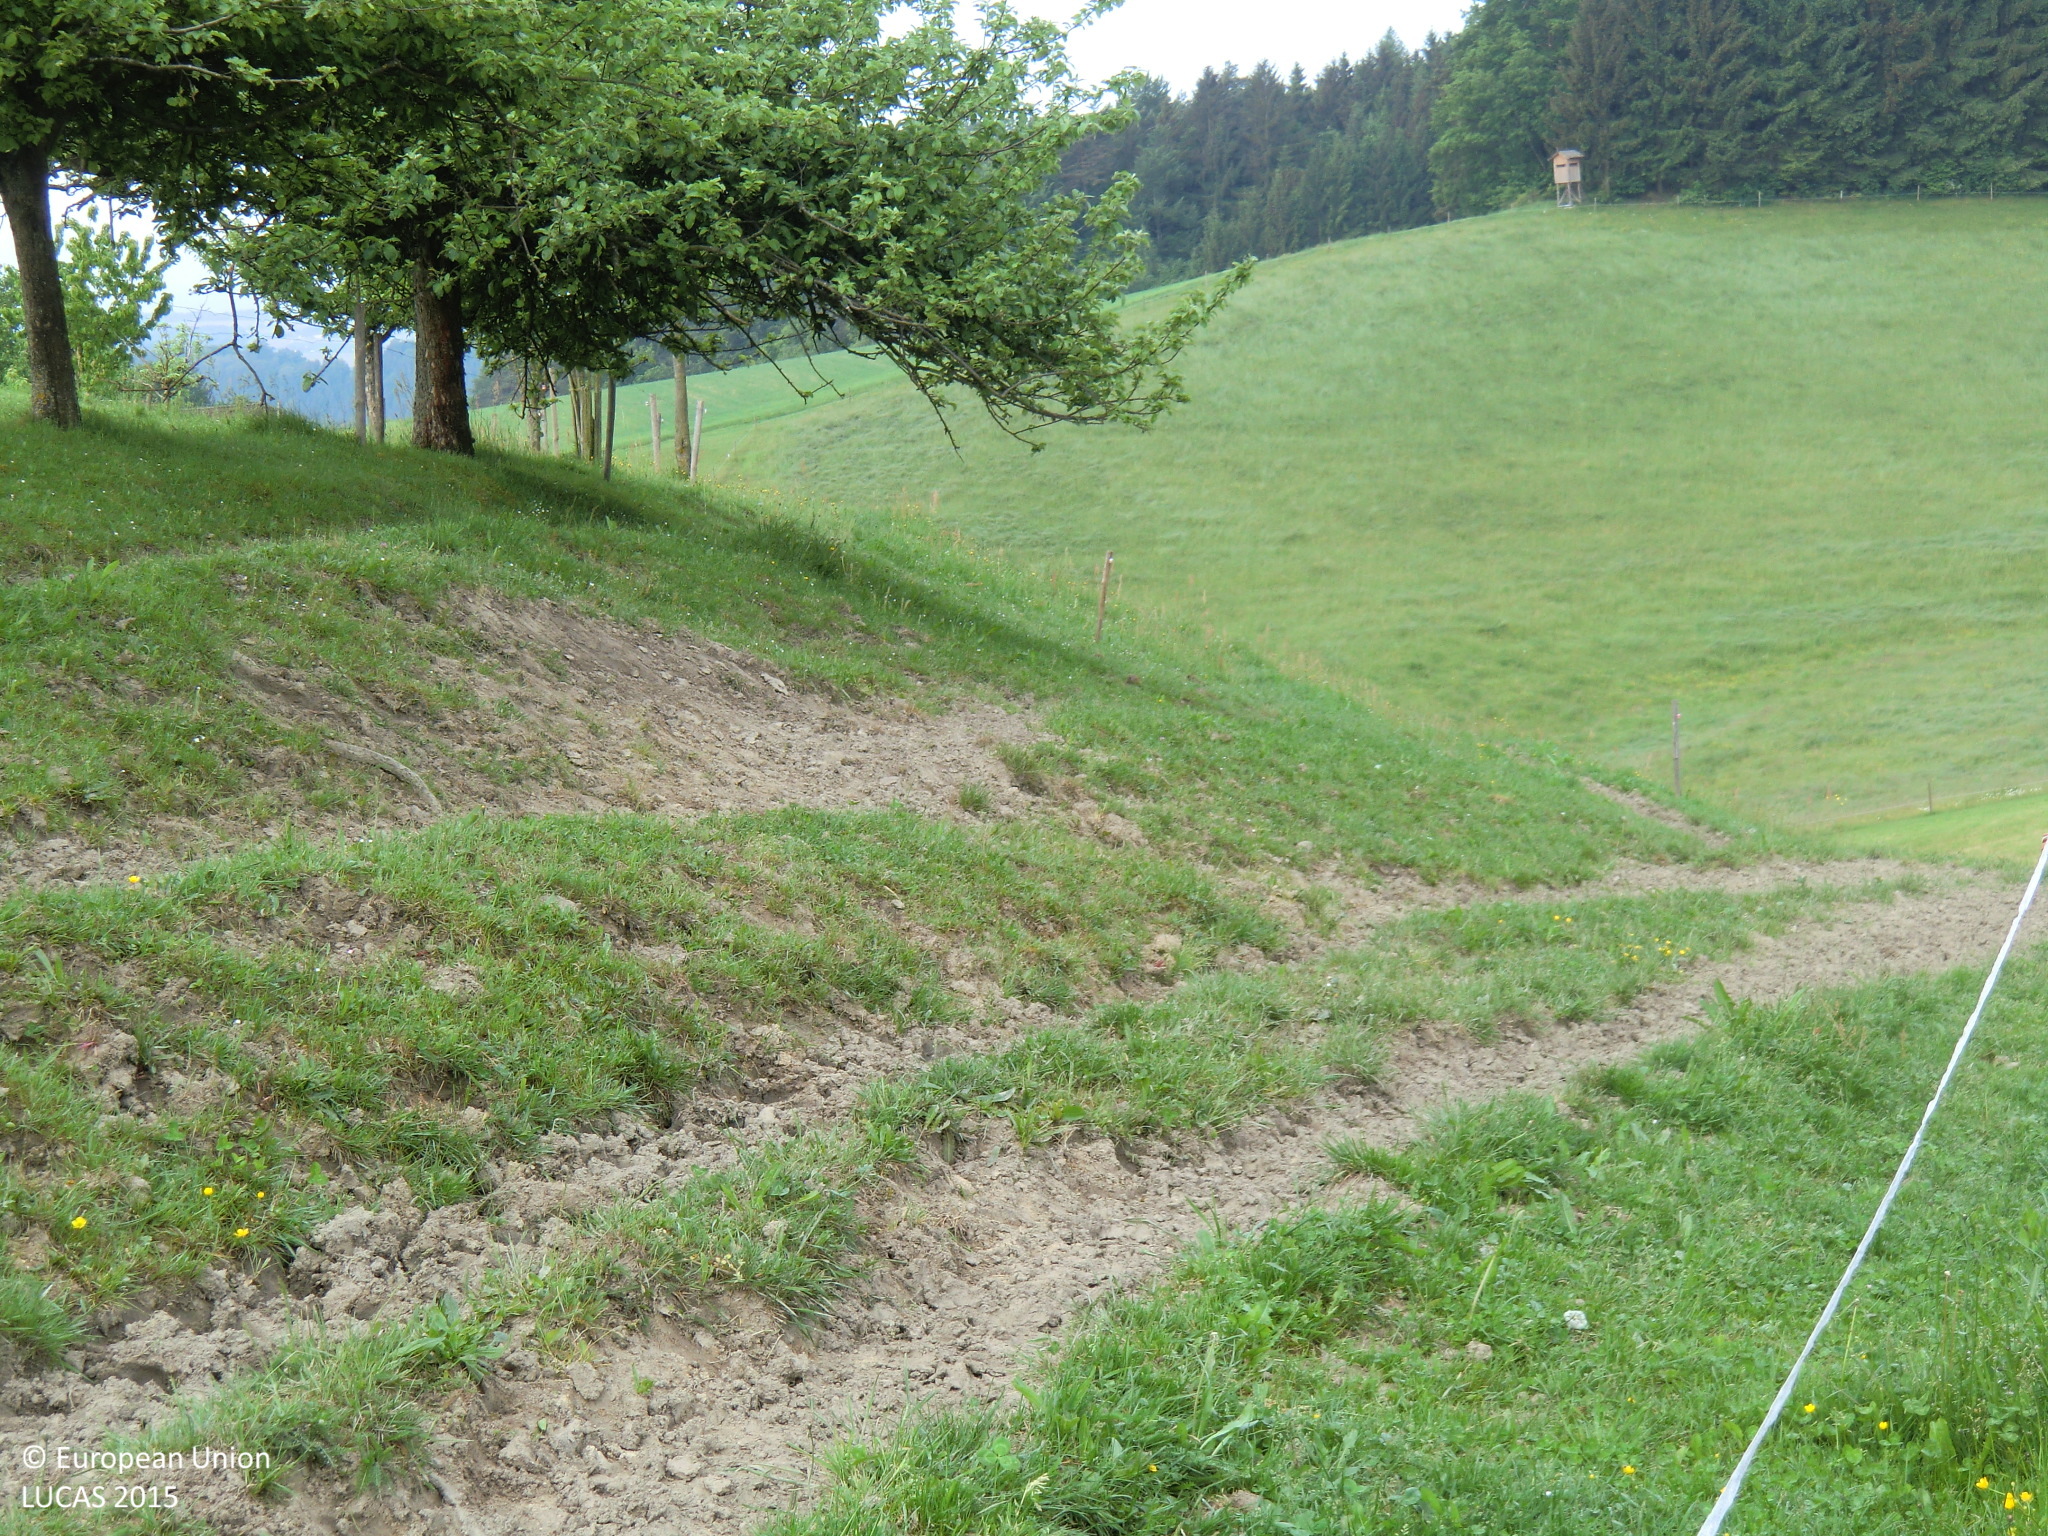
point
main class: Grassland
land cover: Grassland without tree/shrub cover
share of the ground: > 75 %
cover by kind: herbaceous plants 80 %, unconsolidated bare surface 20 %
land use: Agriculture (excluding fallow land and kitchen gardens)
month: May
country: AT
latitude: 48.3079
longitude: 14.5983
